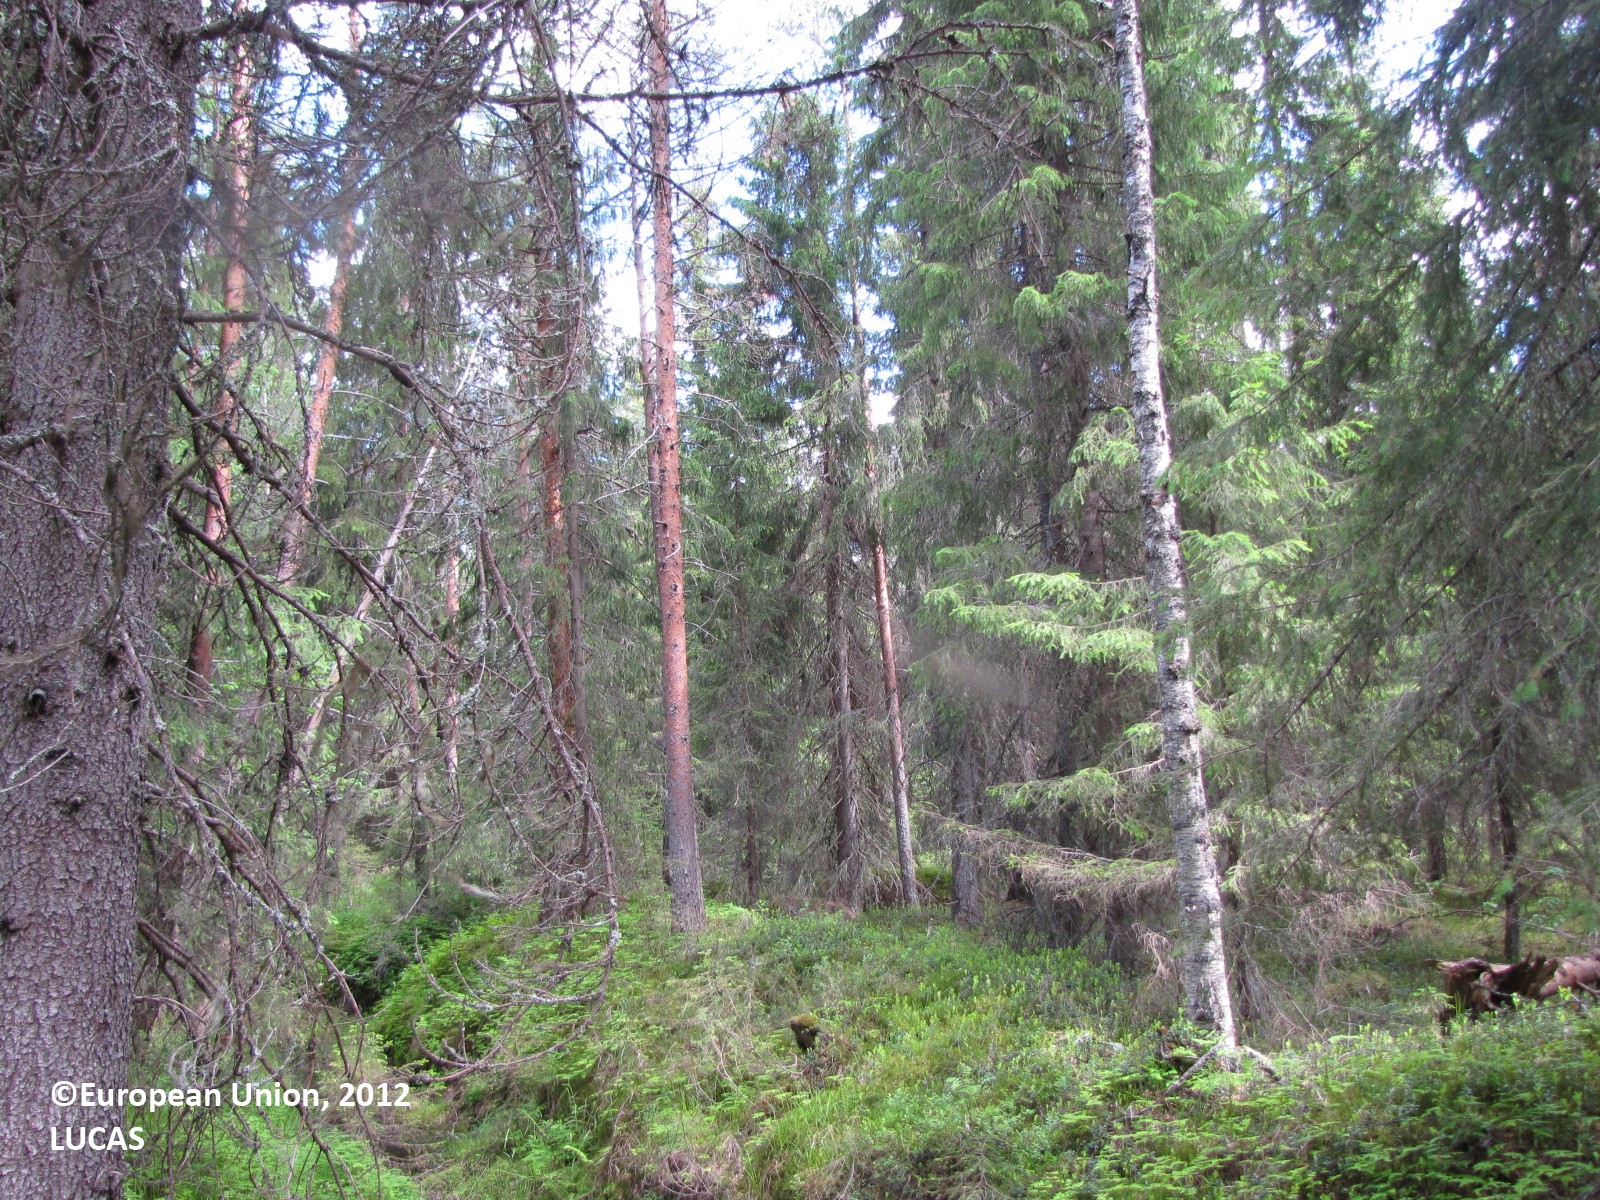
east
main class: Woodland
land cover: Spruce dominated coniferous woodland
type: boreal forest
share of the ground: 50 - 75 %
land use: Forestry
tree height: > 5 m
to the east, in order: Spruce dominated coniferous woodland; Ditches and canals; Spruce dominated coniferous woodland; Pine dominated coniferous woodland; Ditches and canals; Spruce dominated coniferous woodland; Ditches and canals; Spruce dominated coniferous woodland; Ditches and canals; Pine dominated coniferous woodland; Ditches and canals; Pine dominated coniferous woodland; Other mixed woodland
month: July
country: FI
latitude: 66.2377
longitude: 25.1164
